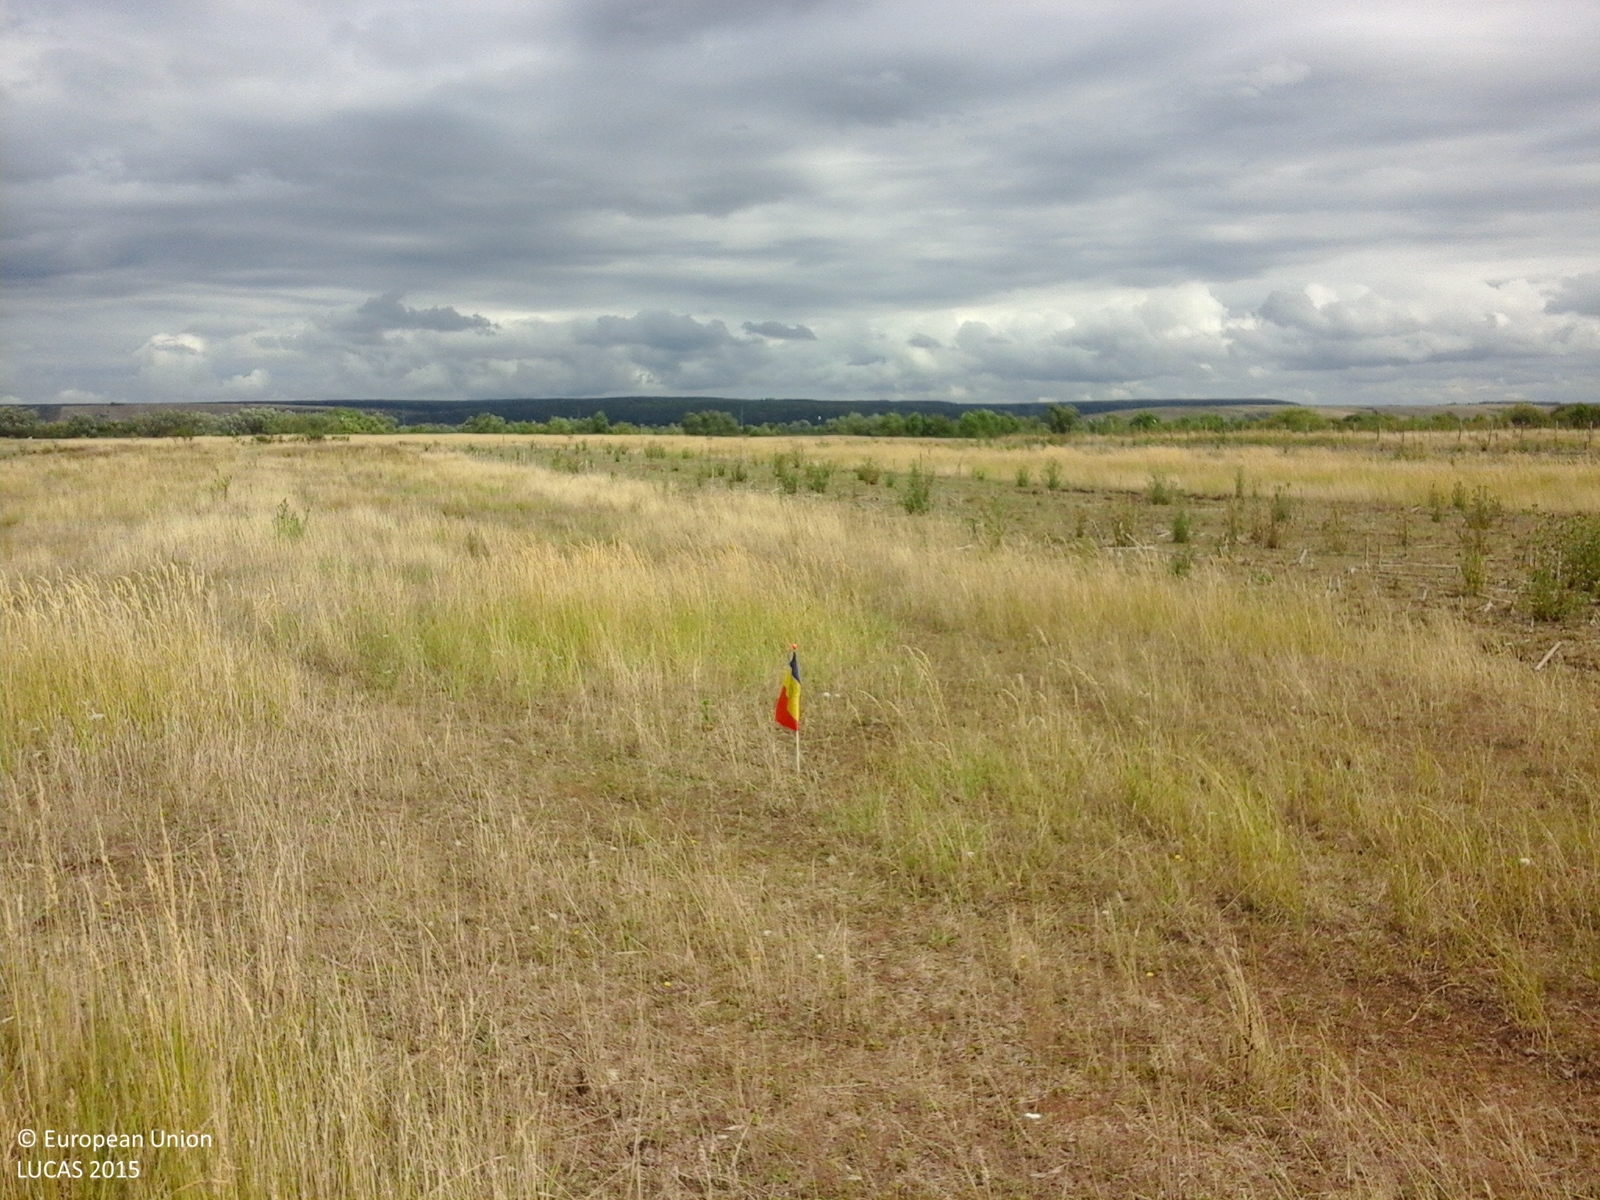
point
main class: Grassland
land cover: Grassland without tree/shrub cover
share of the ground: > 75 %
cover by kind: herbaceous plants 100 %
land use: Agriculture (excluding fallow land and kitchen gardens)
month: August
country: RO
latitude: 45.4267
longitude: 21.5999
